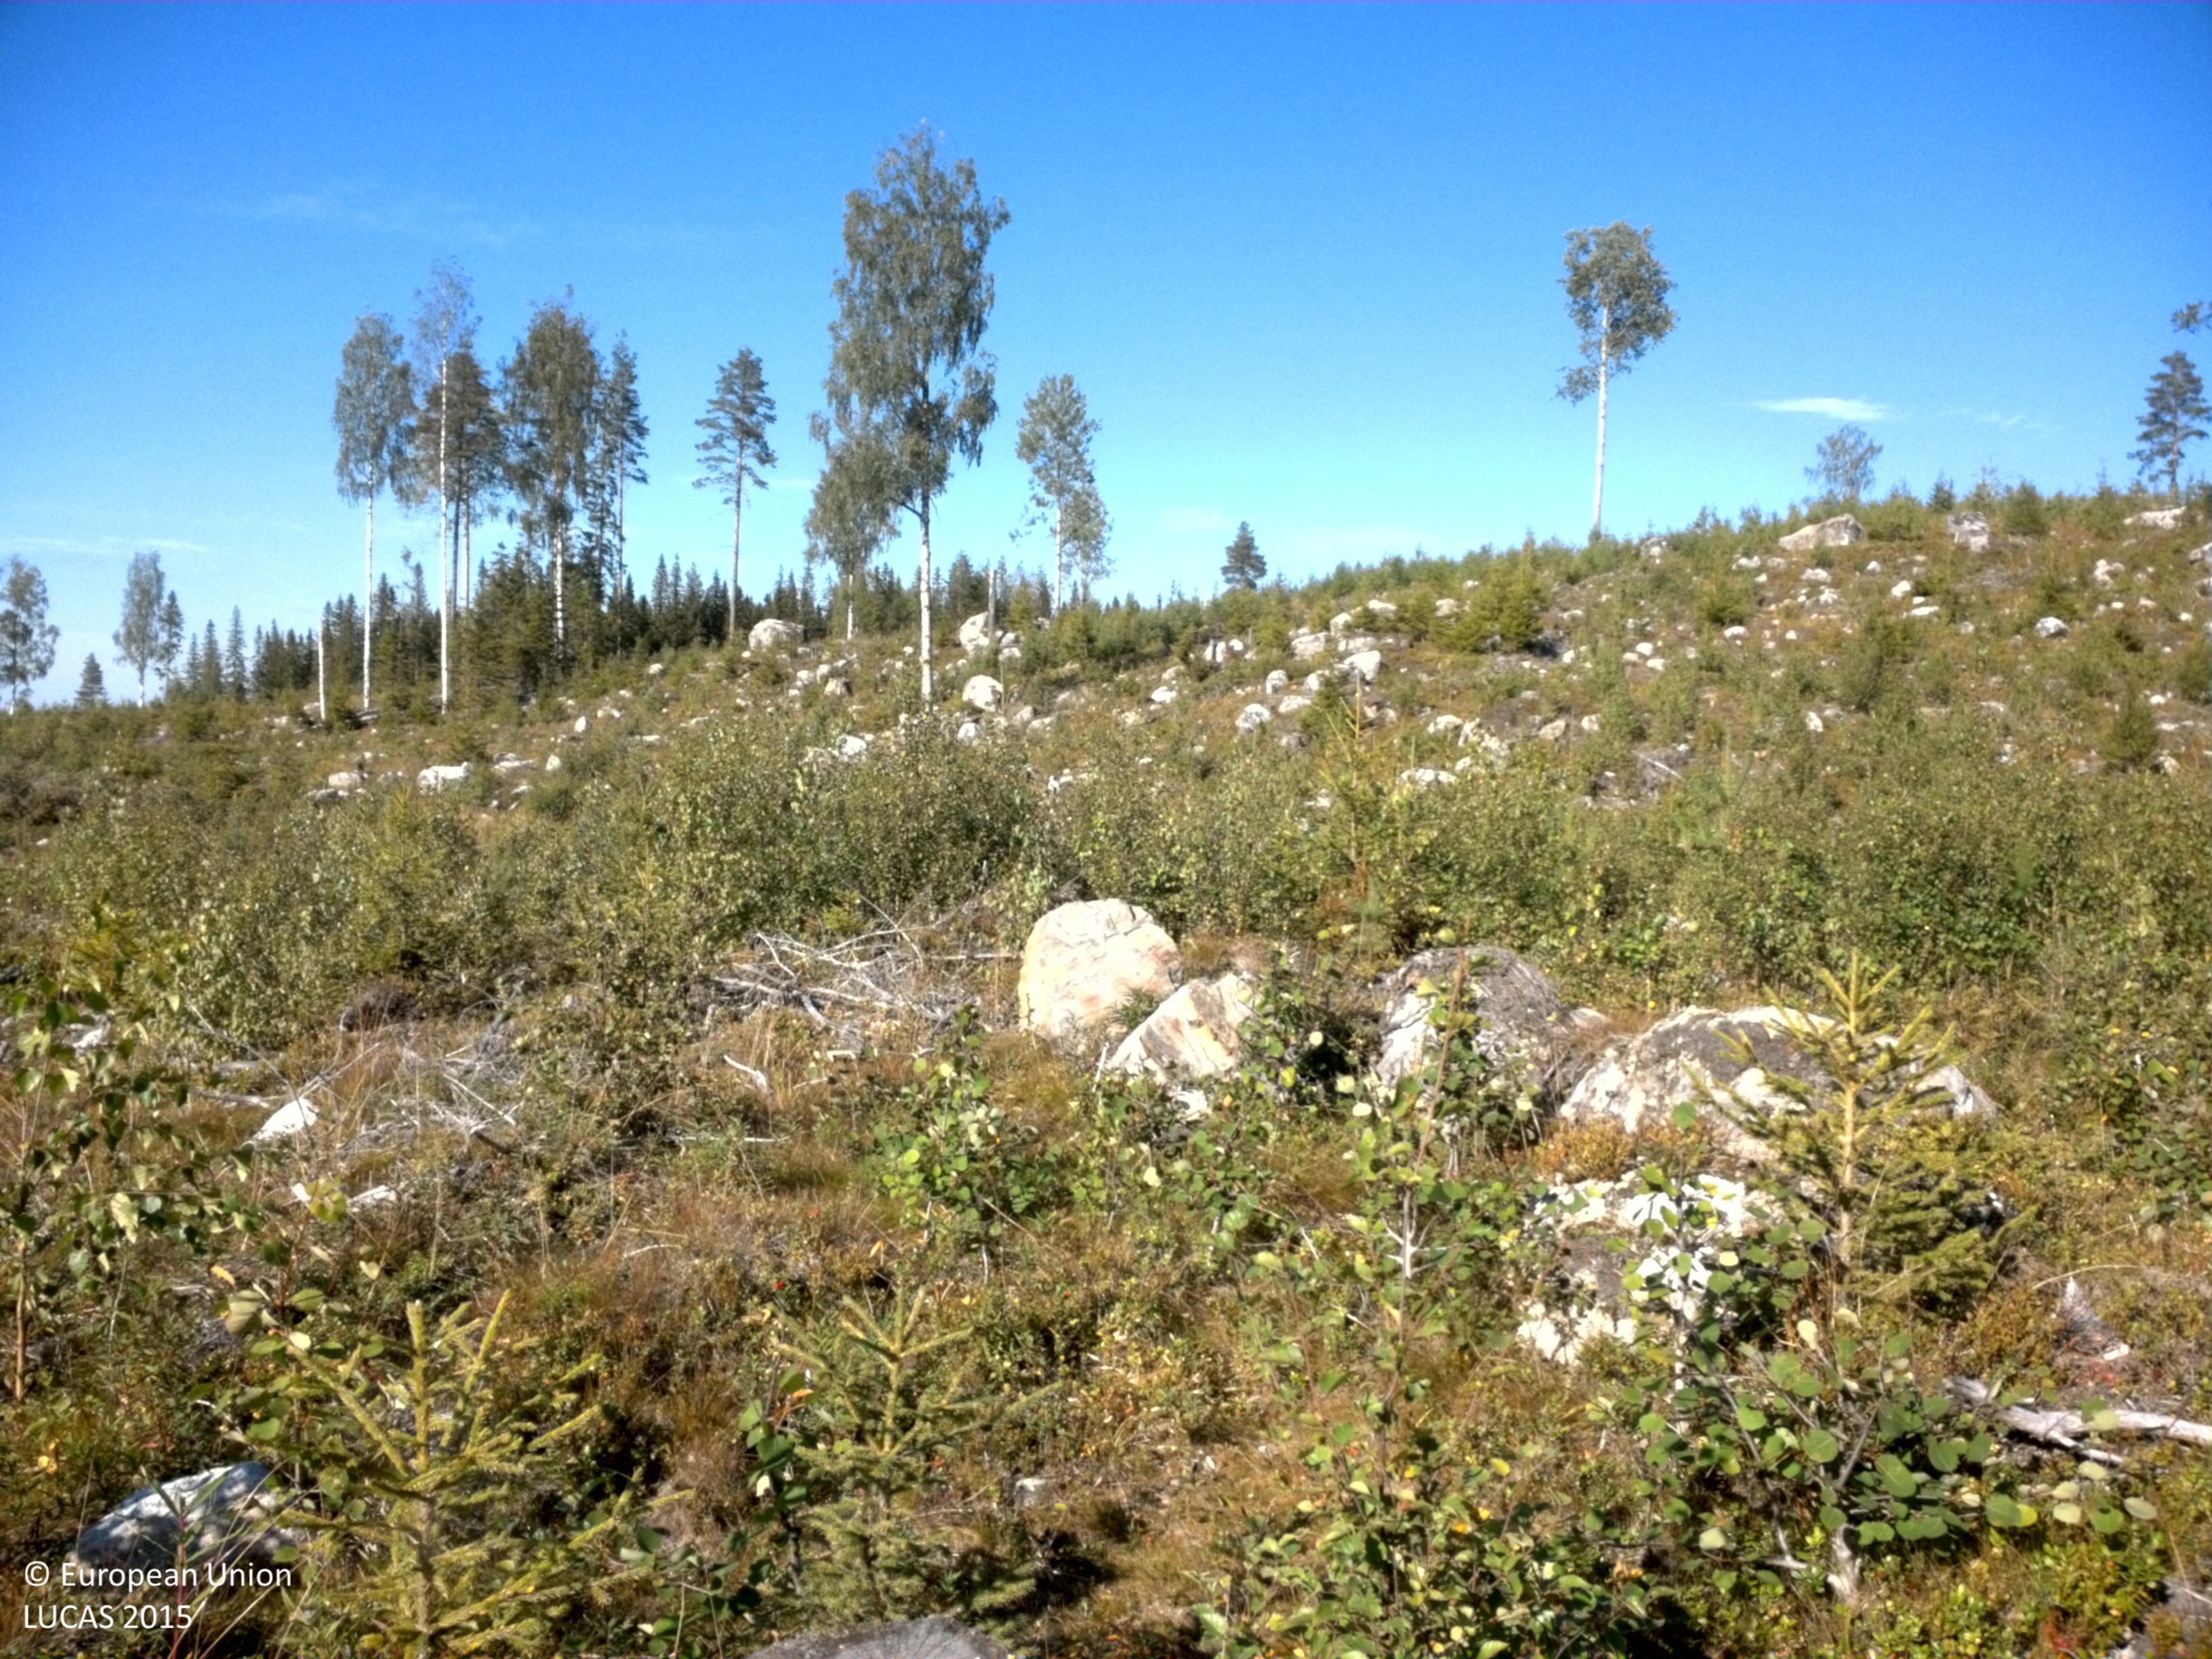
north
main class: Woodland
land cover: Broadleaved woodland
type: boreal forest
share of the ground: 25 - 50 %
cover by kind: shrubs 50 %, broadleaved forest trees 40 %, coniferous forest trees 5 %, herbaceous plants 5 %
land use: Forestry
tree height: < 5 m
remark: Clear cut
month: August
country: SE
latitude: 64.3058
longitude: 19.0050
